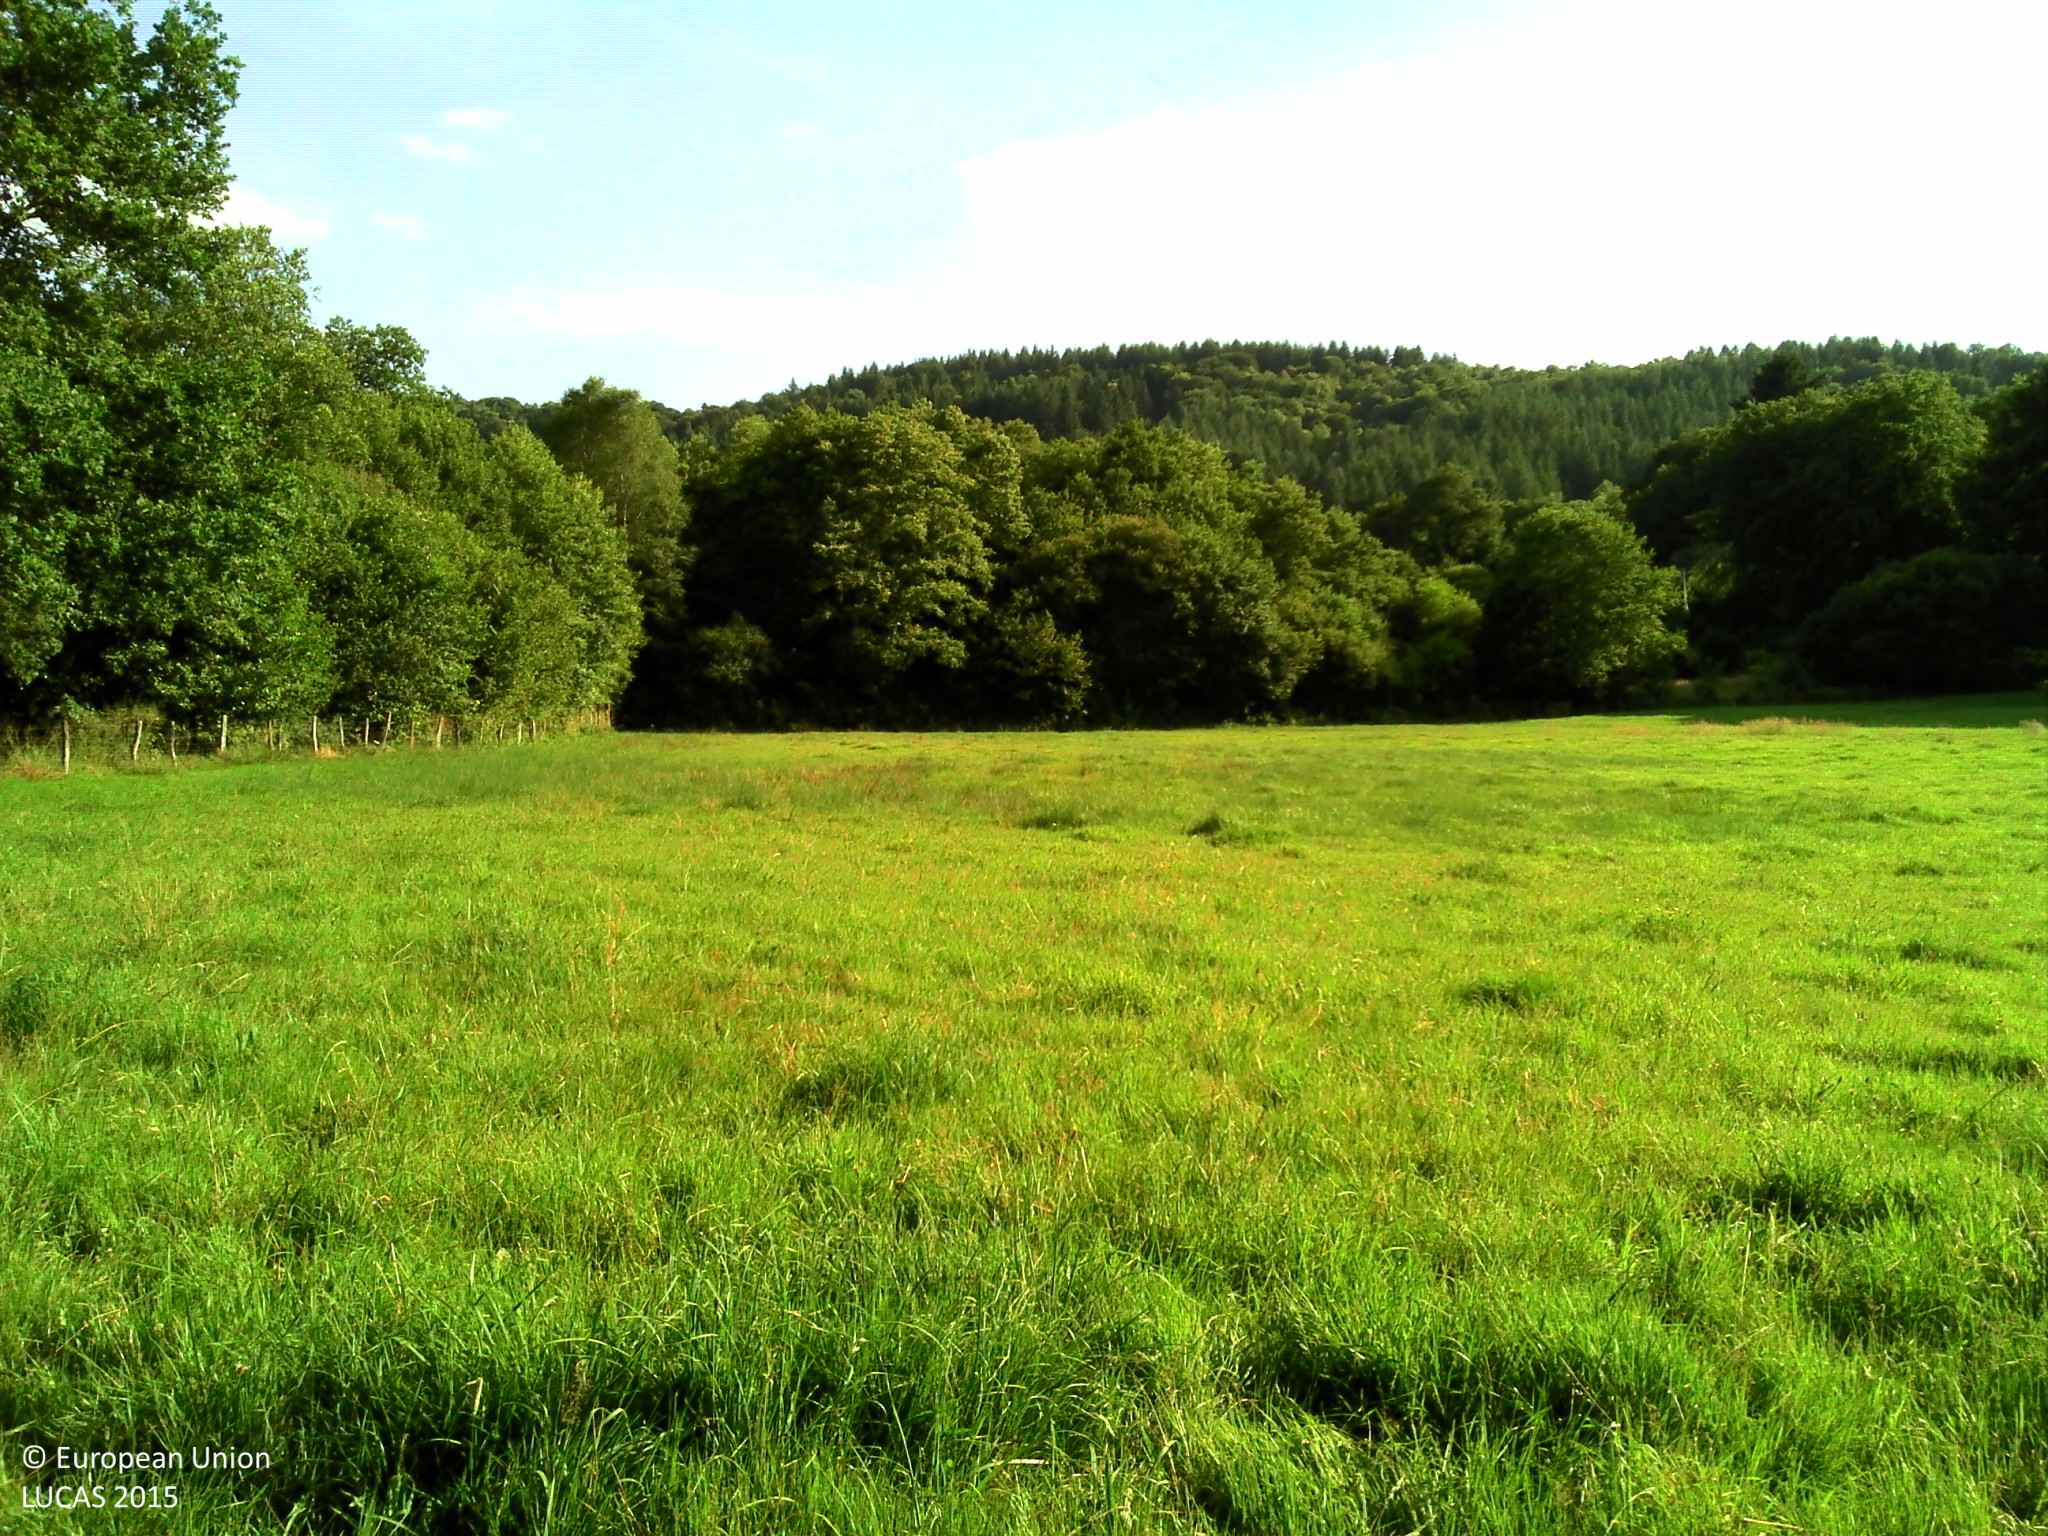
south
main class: Grassland
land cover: Grassland without tree/shrub cover
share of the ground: > 75 %
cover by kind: herbaceous plants 95 %
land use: Agriculture (excluding fallow land and kitchen gardens)
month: July
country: FR
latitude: 45.6912
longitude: 1.7889
